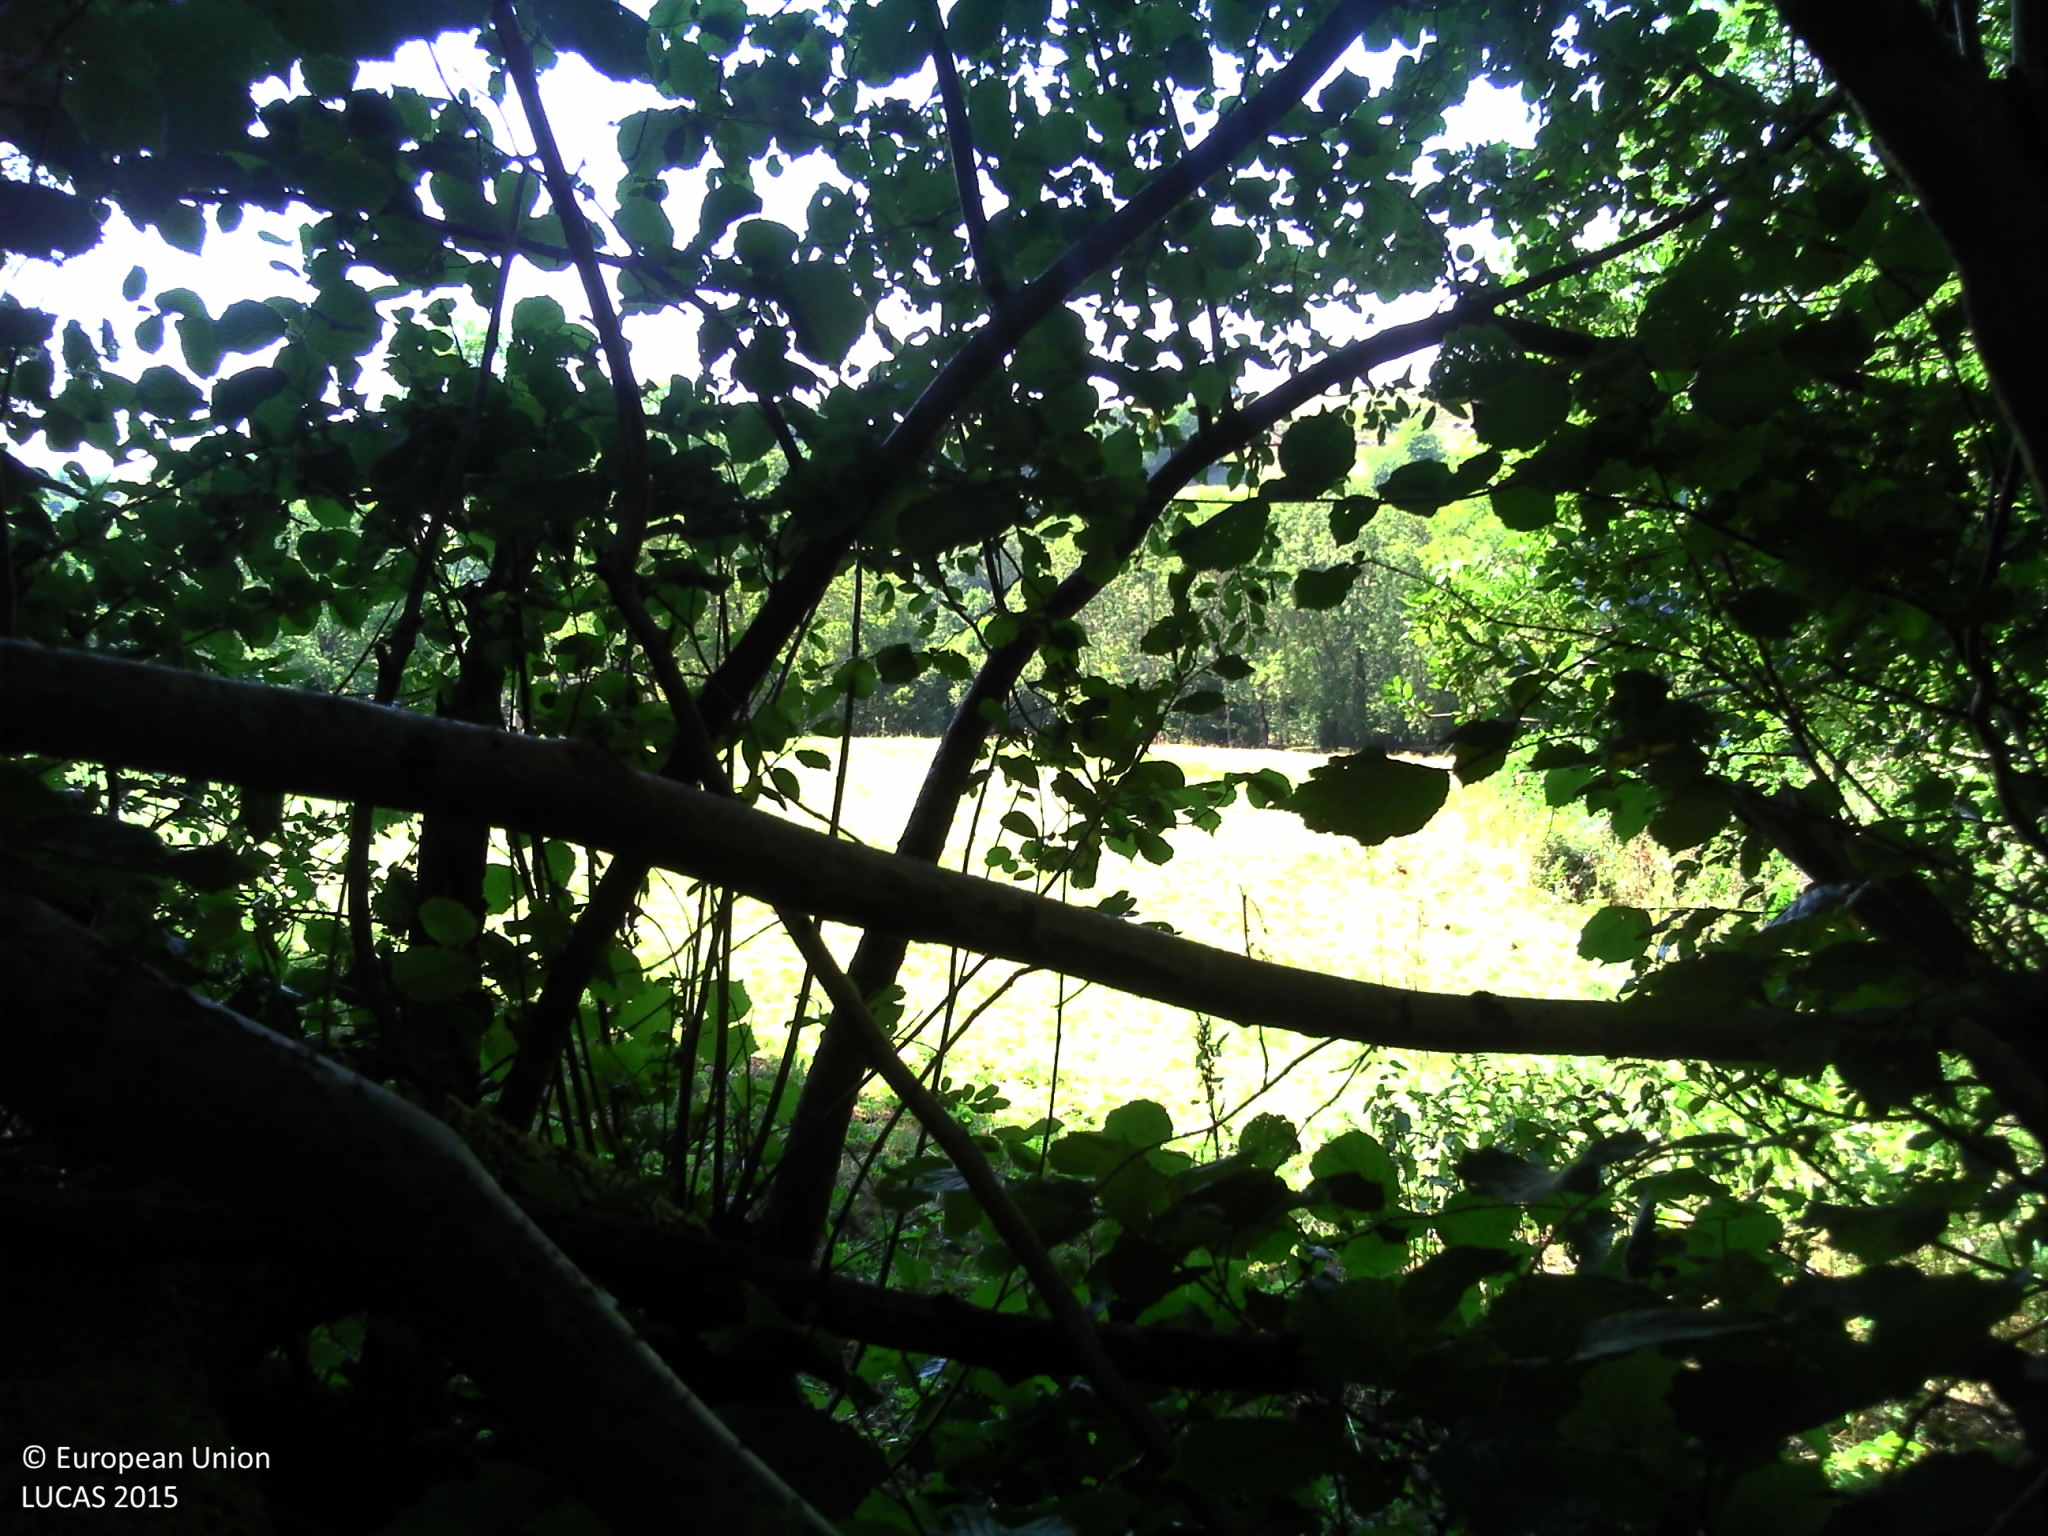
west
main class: Woodland
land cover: Broadleaved woodland
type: mesophytic deciduous forest
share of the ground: > 75 %
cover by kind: broadleaved forest trees 50 %, herbaceous plants 30 %, unconsolidated bare surface 20 %
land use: Agriculture (excluding fallow land and kitchen gardens)
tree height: > 5 m
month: August
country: FR
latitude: 45.6991
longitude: 2.8971
